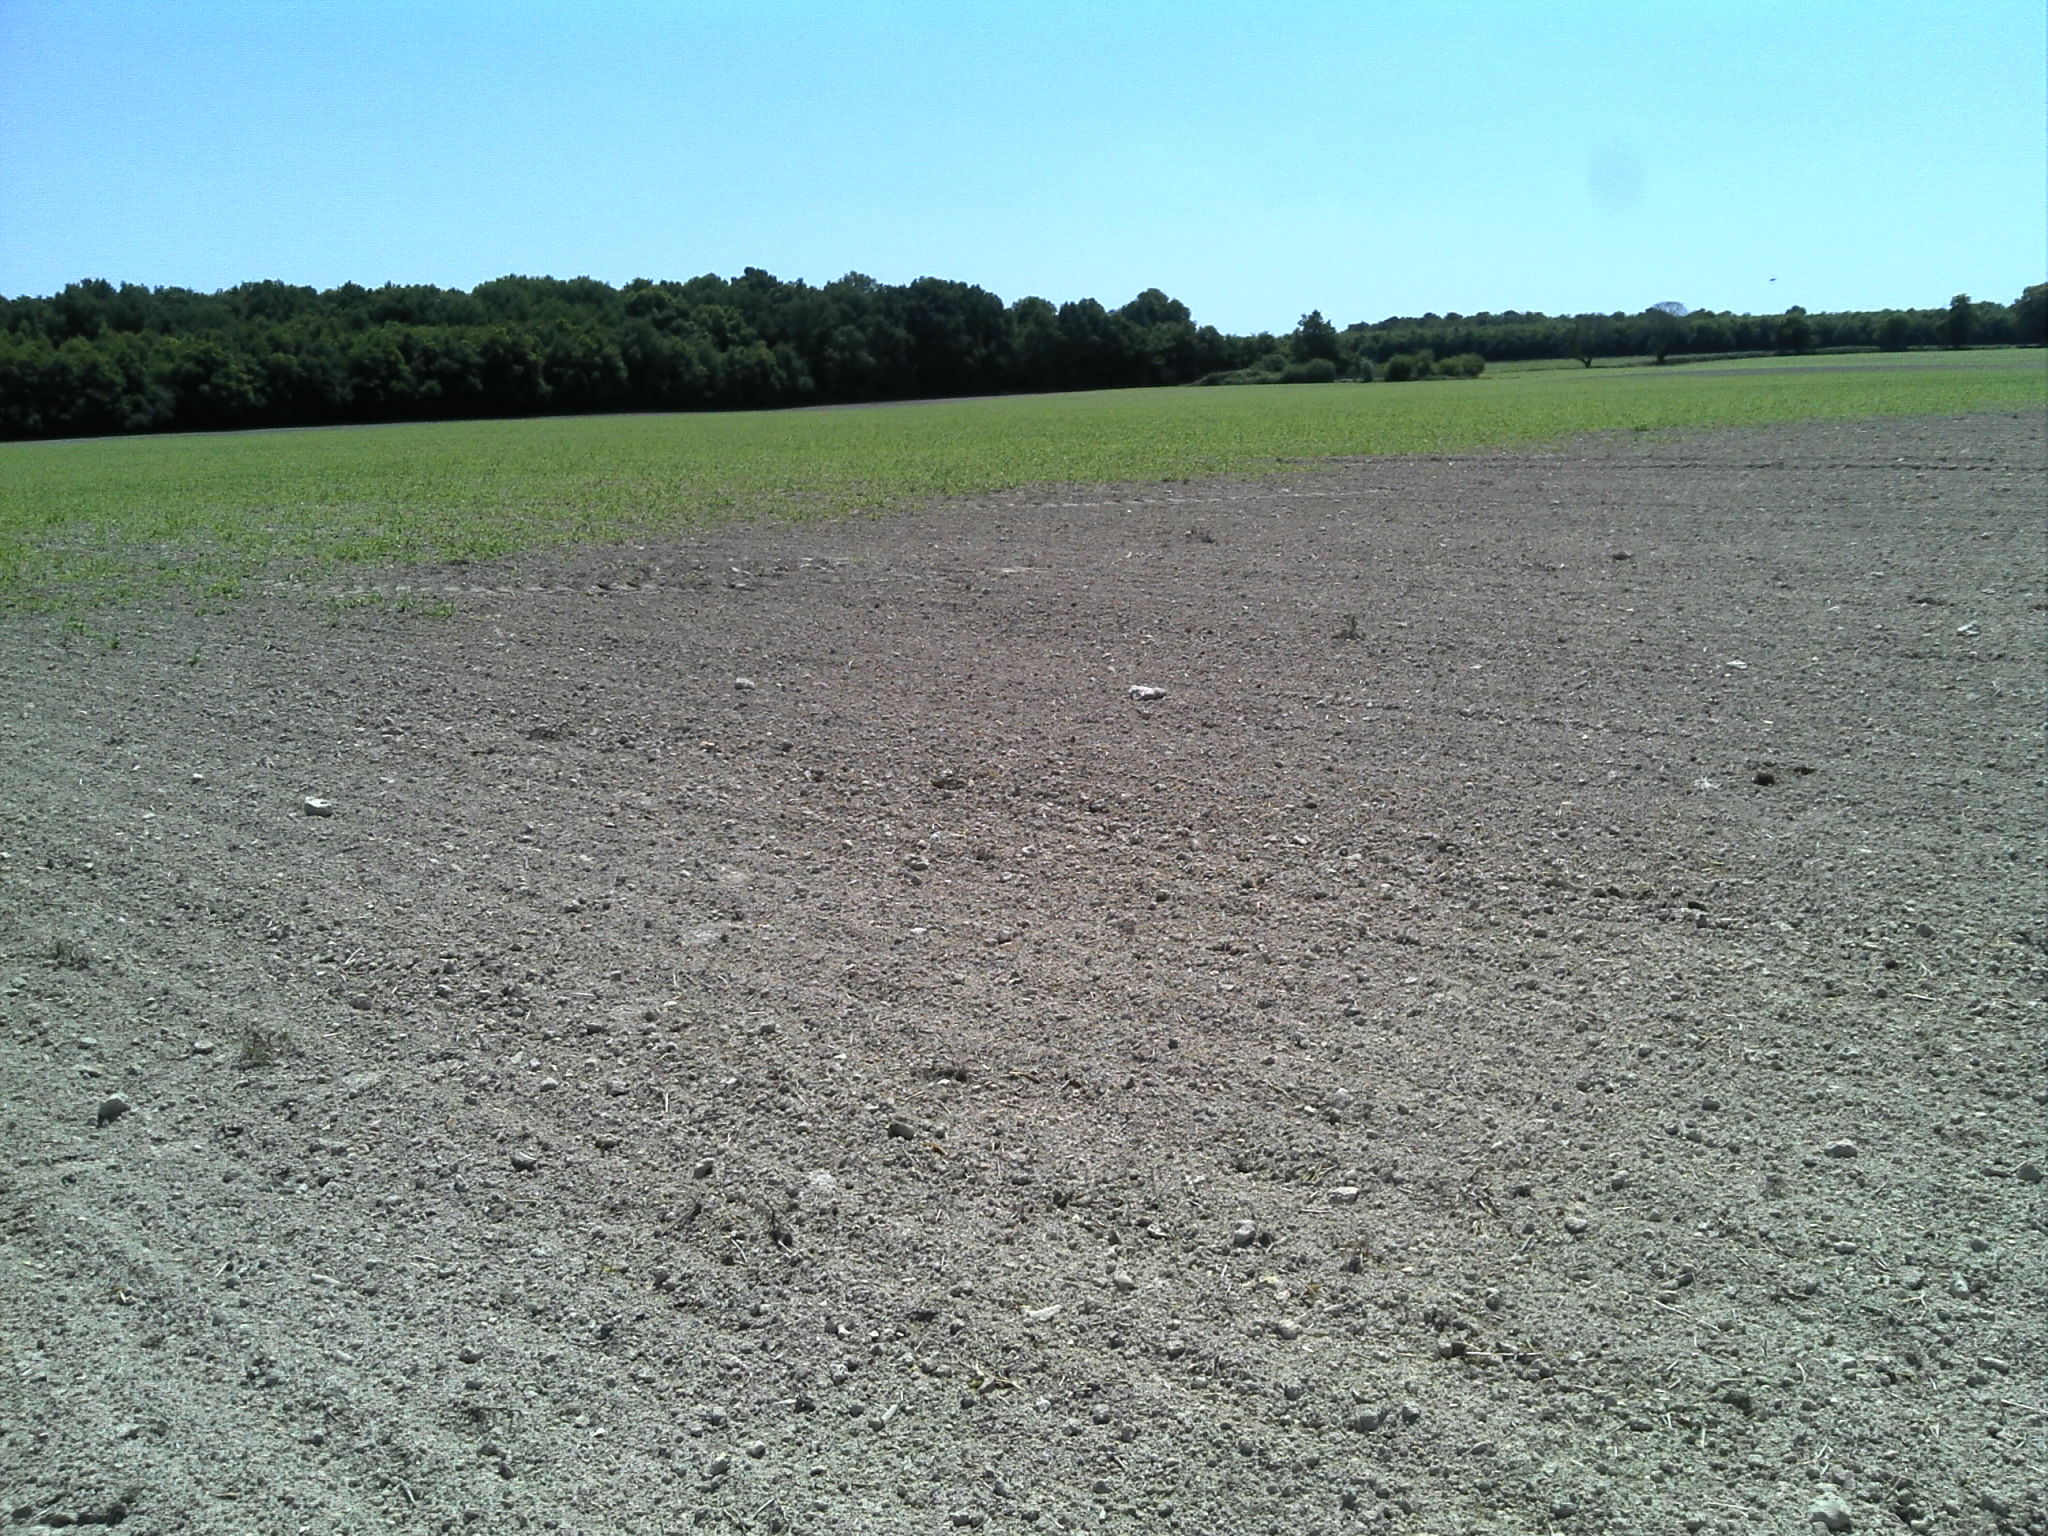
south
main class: Cropland
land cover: Maize
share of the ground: < 10 %
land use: Agriculture (excluding fallow land and kitchen gardens)
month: June
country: FR
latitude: 47.1451
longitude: 1.4021
